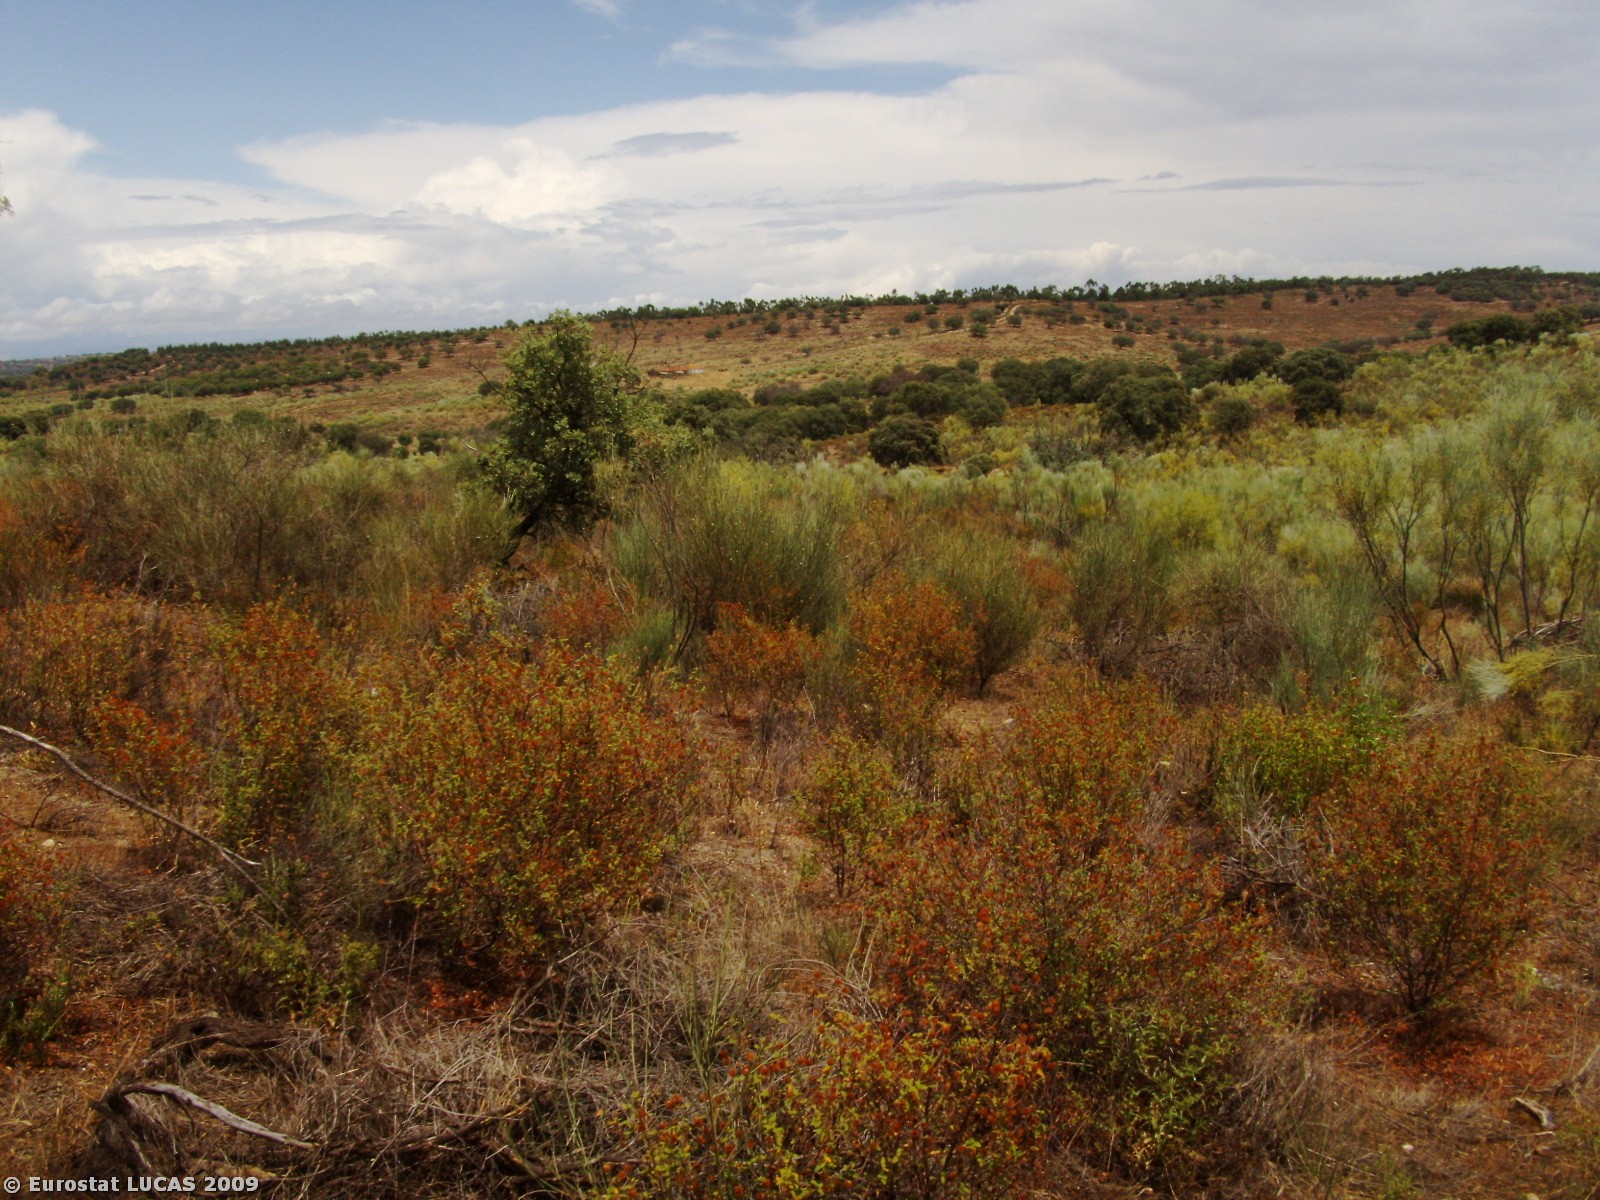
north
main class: Shrubland
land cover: Shrubland without tree cover
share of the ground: > 75 %
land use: Unused
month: June
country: PT
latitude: 39.7250
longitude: -7.1337
